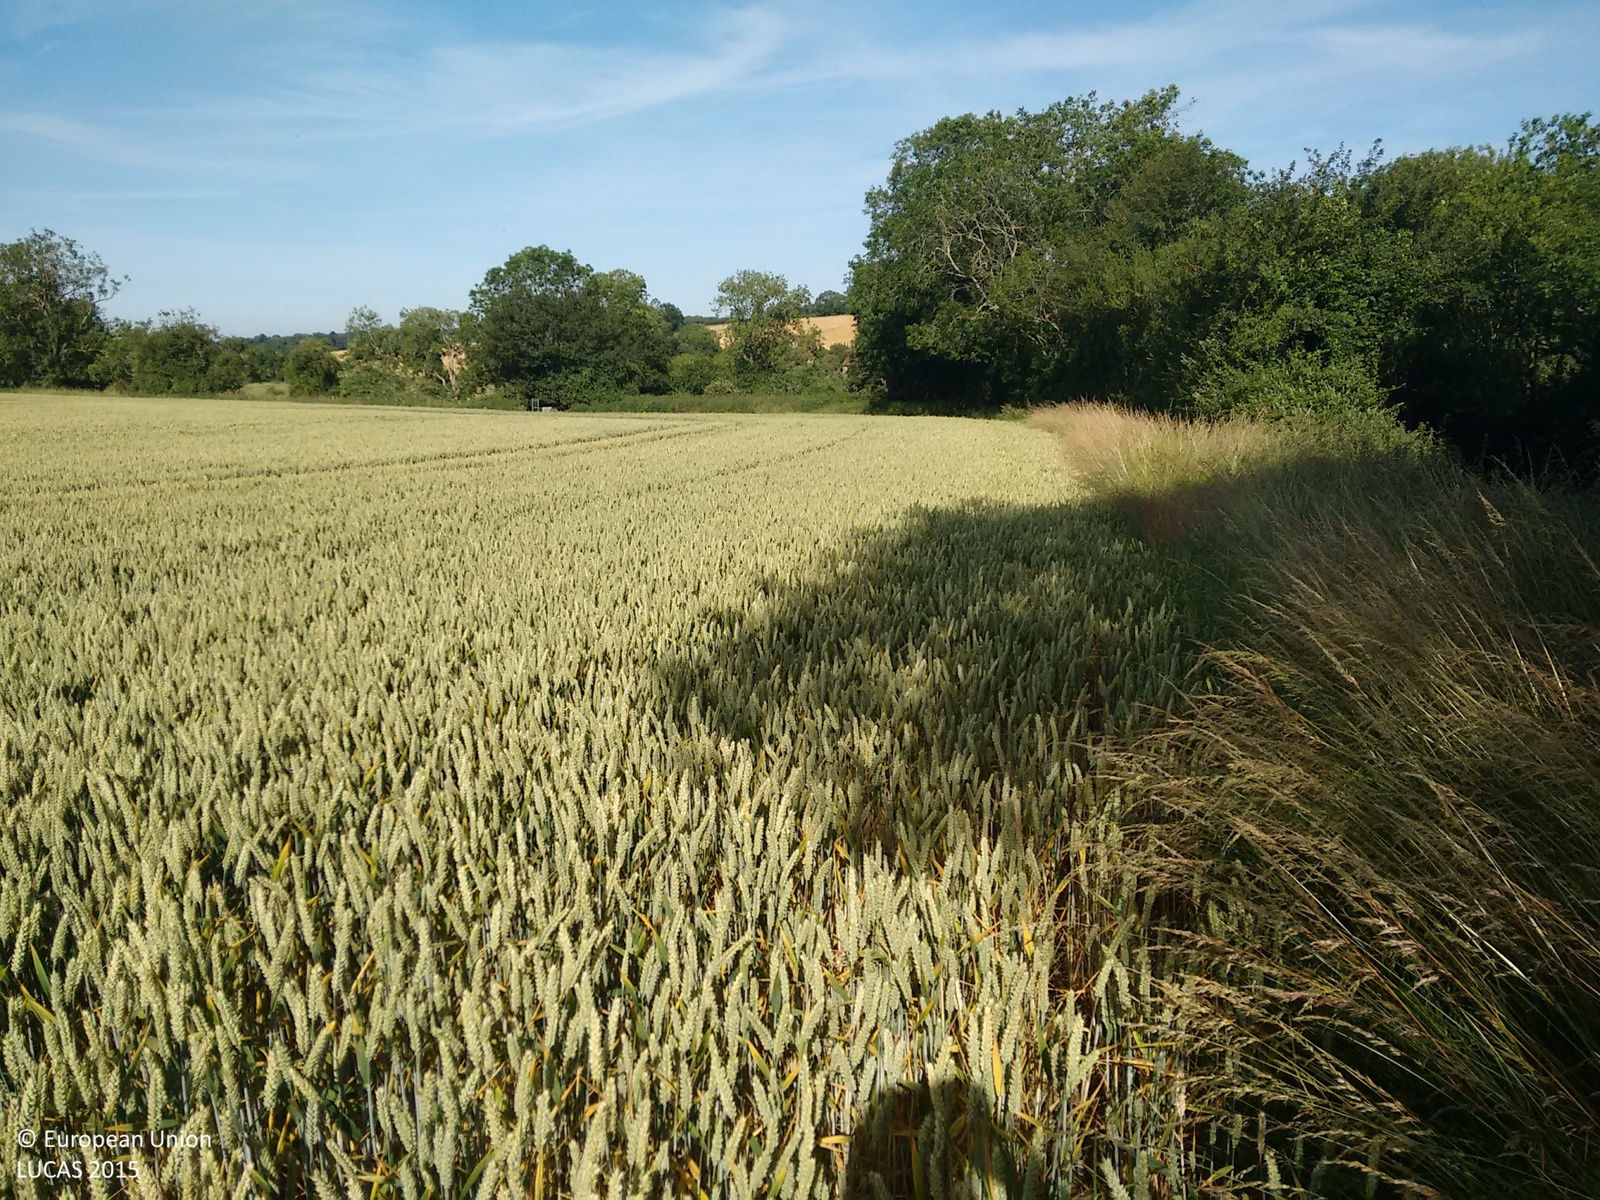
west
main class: Cropland
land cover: Common wheat
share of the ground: 50 - 75 %
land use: Agriculture (excluding fallow land and kitchen gardens)
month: July
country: GB
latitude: 50.8771
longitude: -0.8867
